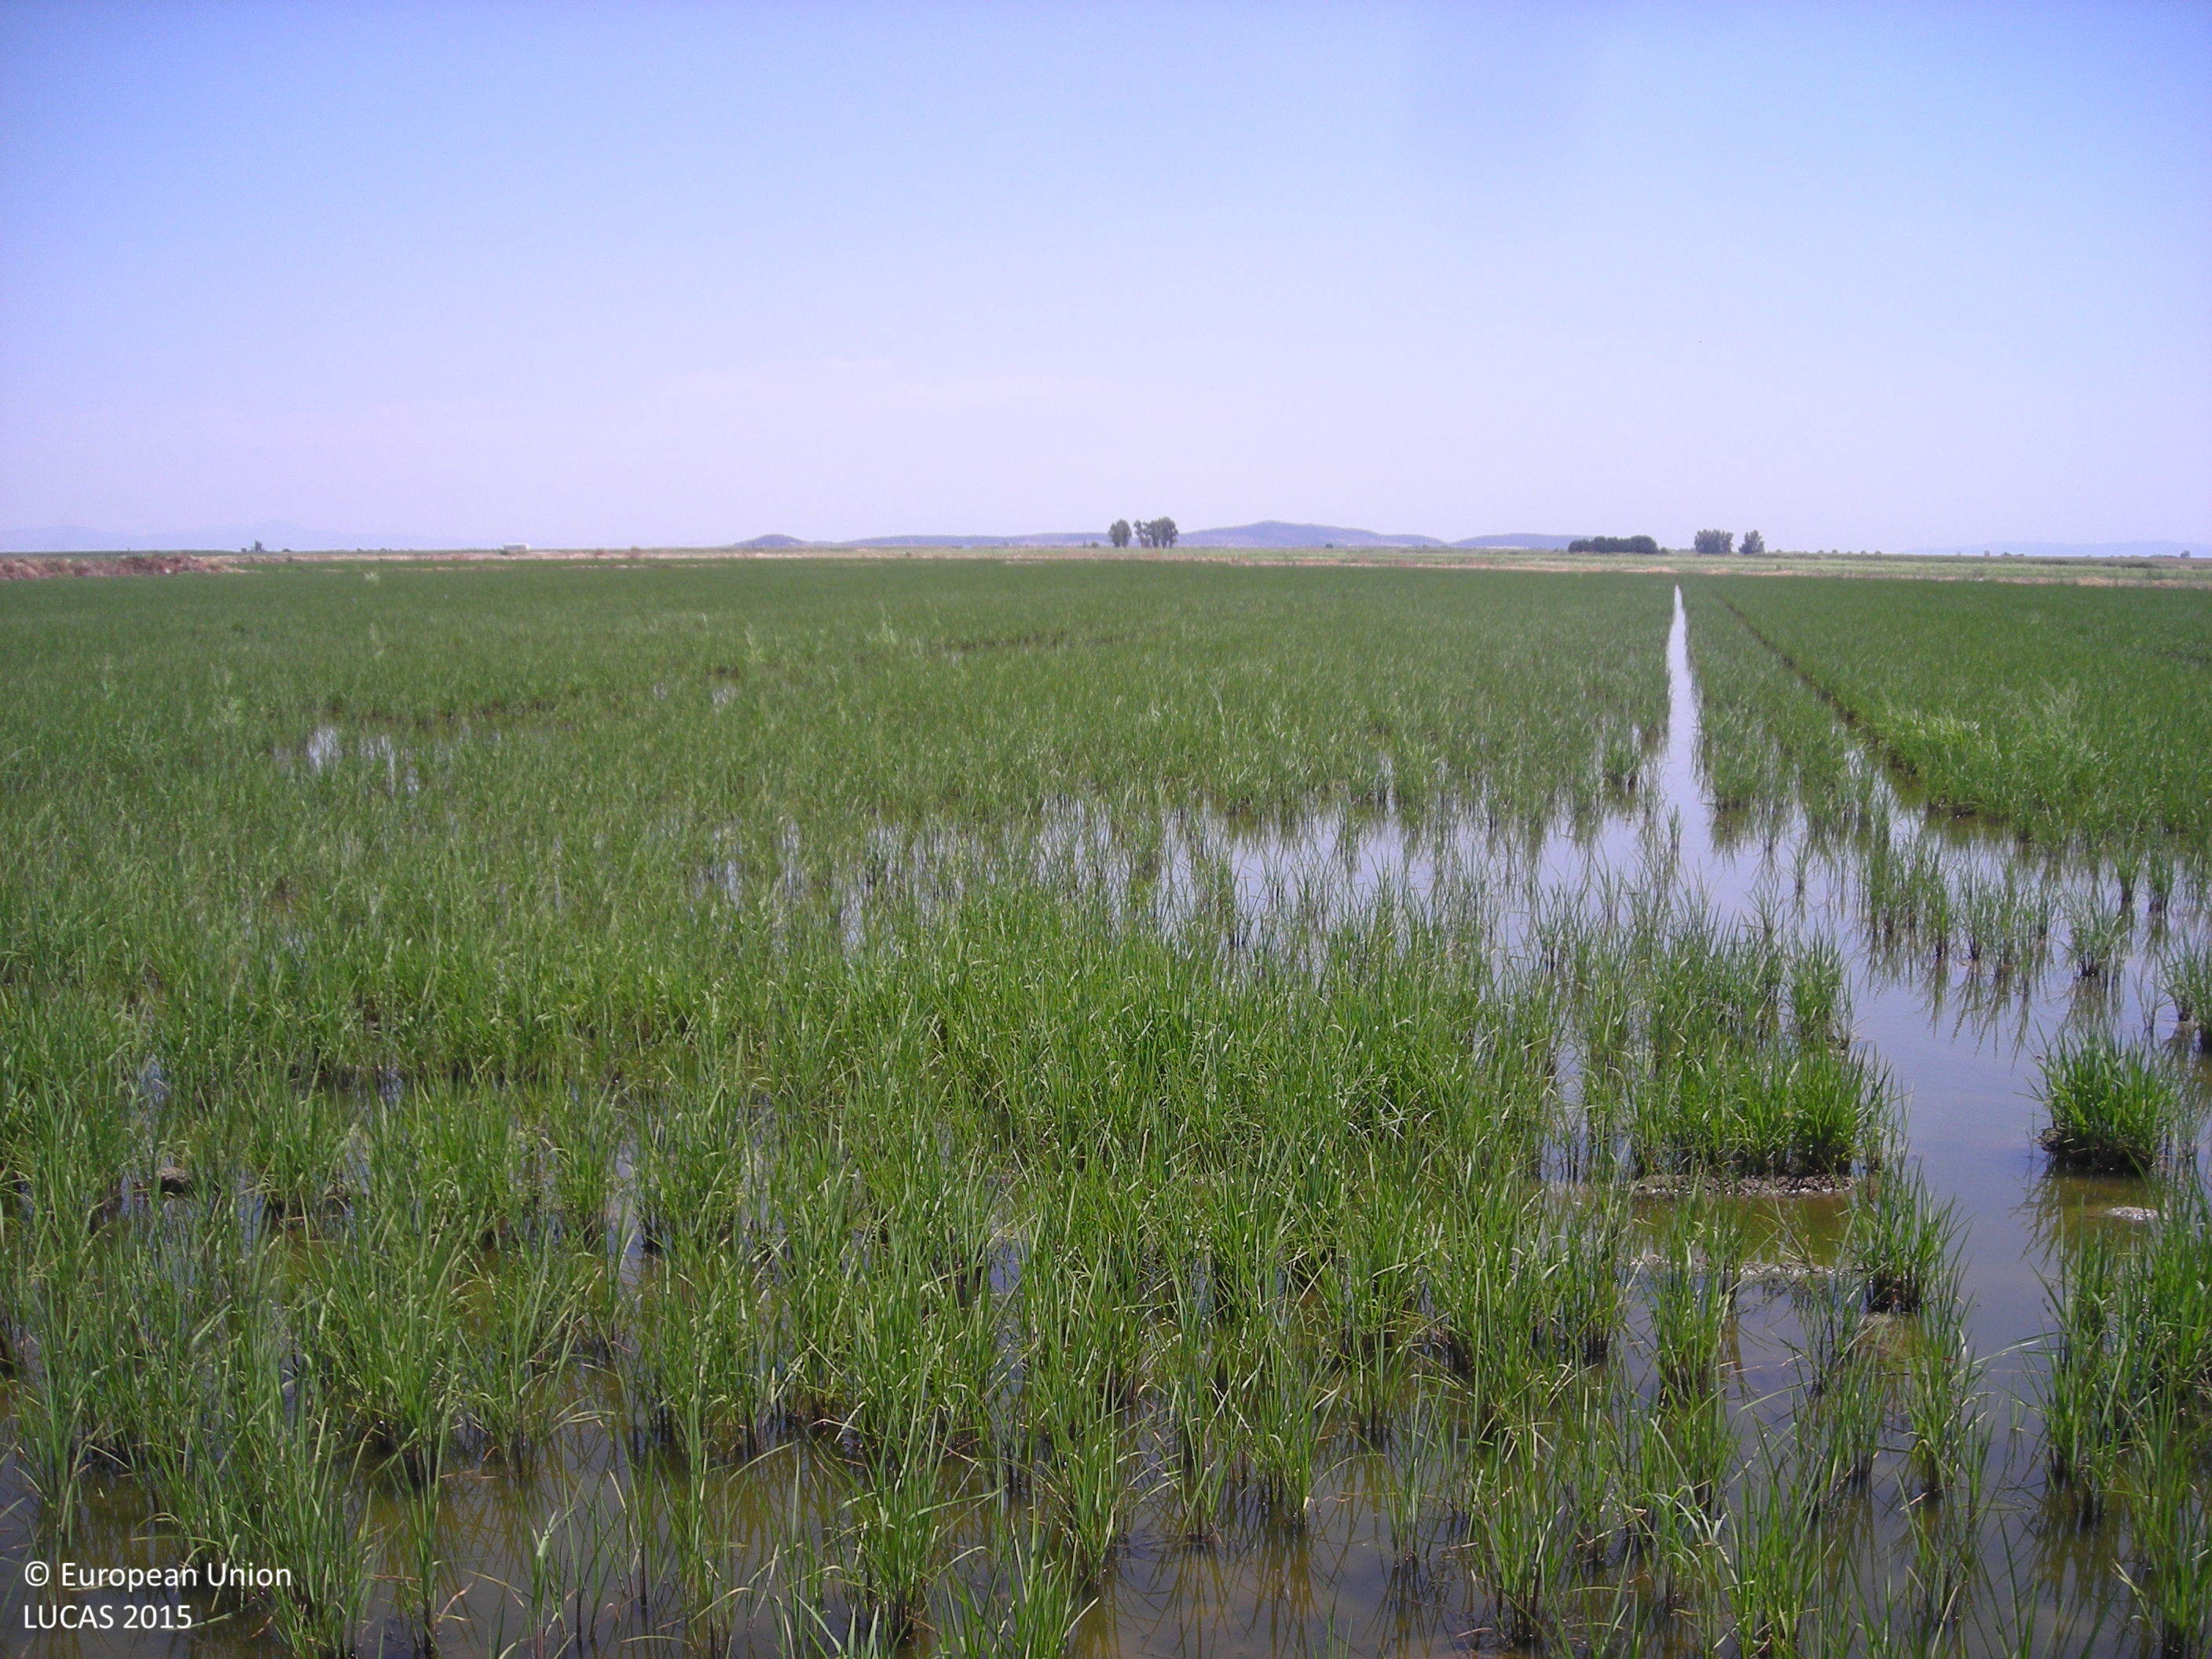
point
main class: Cropland
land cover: Rice
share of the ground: > 75 %
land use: Agriculture (excluding fallow land and kitchen gardens)
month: July
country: ES
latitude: 39.0215
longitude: -5.9803
